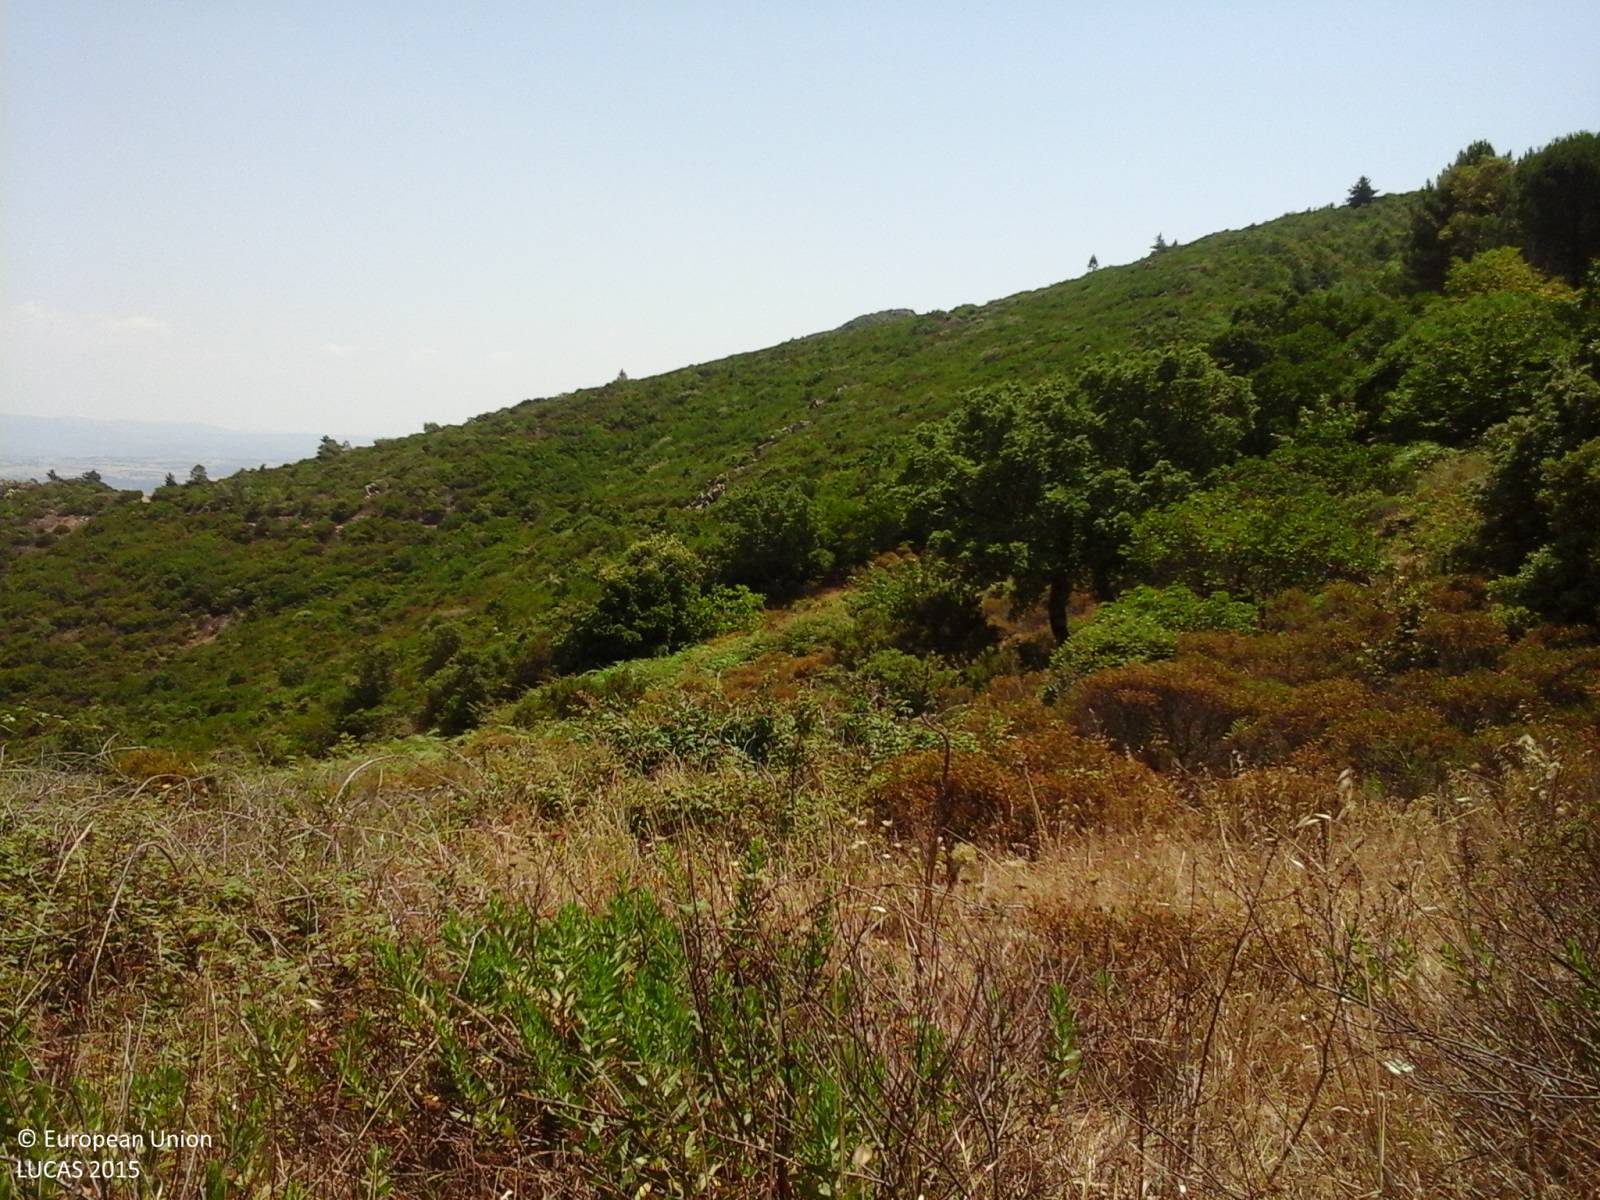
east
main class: Shrubland
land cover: Shrubland without tree cover
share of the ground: > 75 %
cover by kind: shrubs 100 %
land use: Semi-natural and natural areas not in use
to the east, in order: Shrubland without tree cover; Tracks; Broadleaved woodland
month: July
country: IT
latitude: 39.9344
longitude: 8.8246
